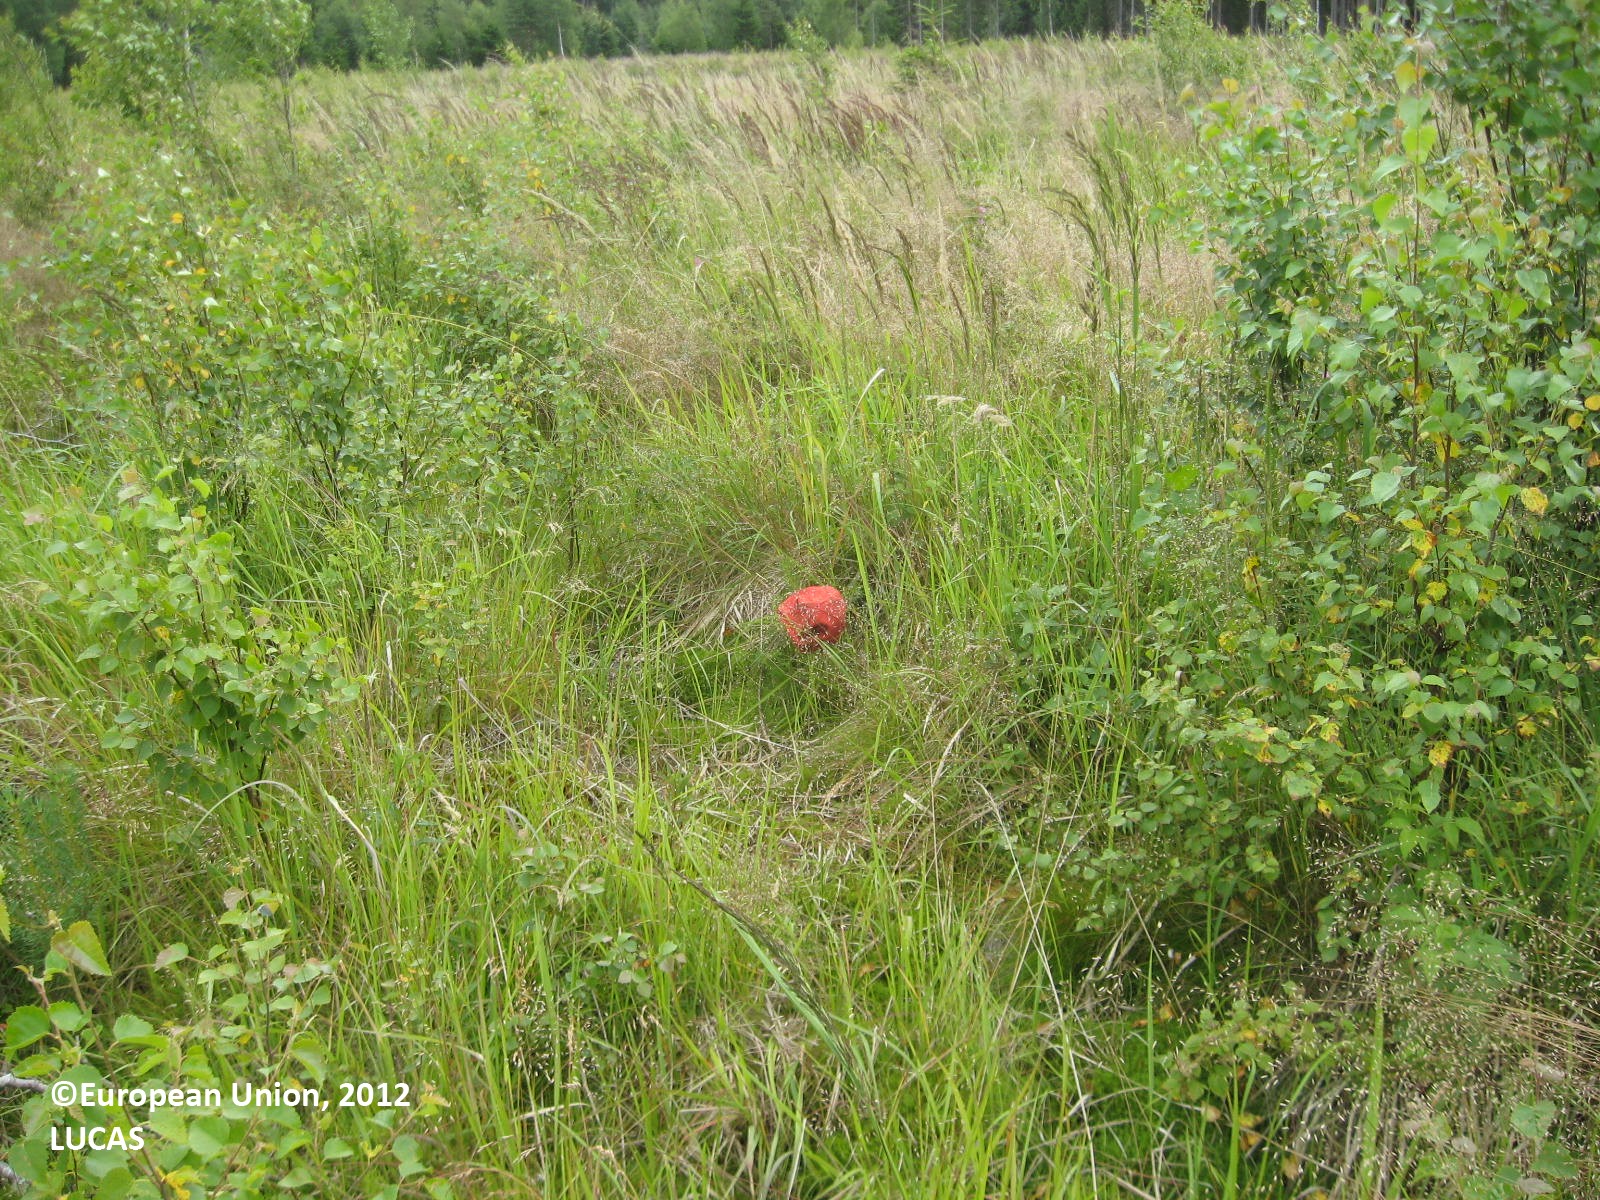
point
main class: Woodland
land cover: Broadleaved woodland
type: boreal forest
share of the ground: 10 - 25 %
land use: Forestry
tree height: < 5 m
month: July
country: FI
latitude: 61.9803
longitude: 21.3609
